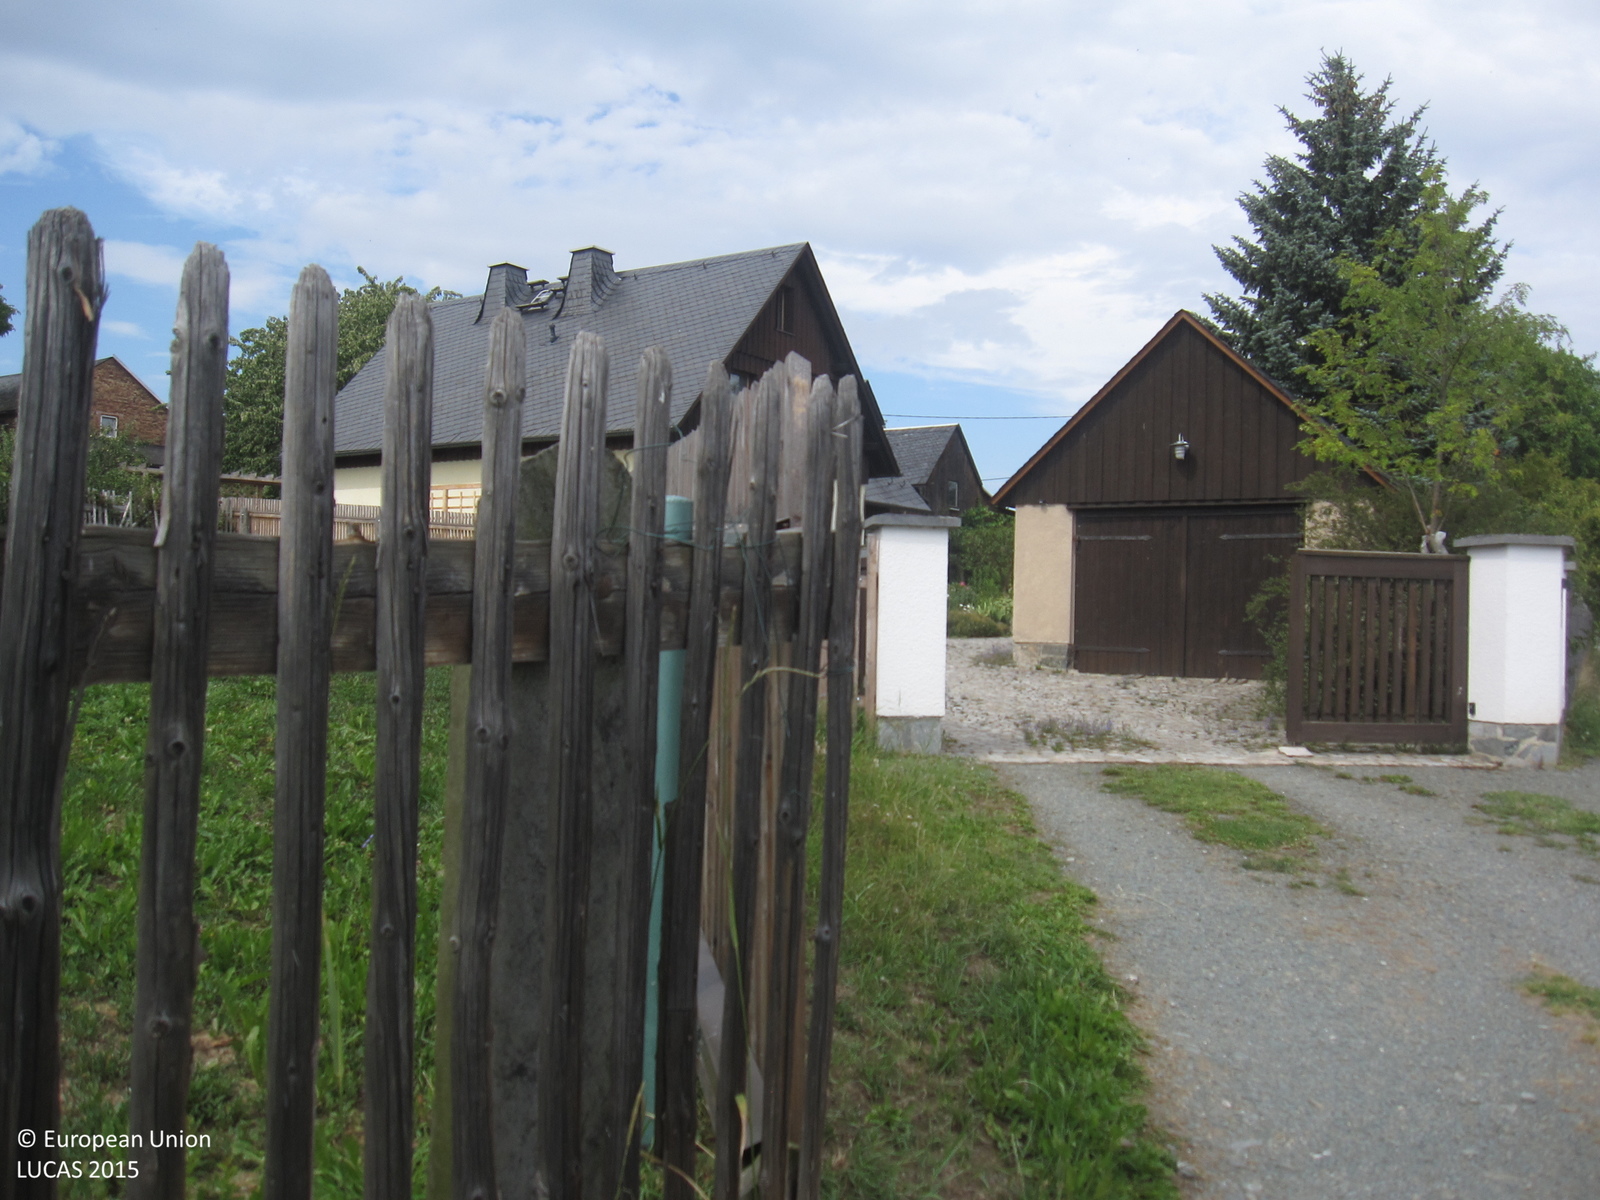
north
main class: Woodland
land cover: Broadleaved woodland
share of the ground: 25 - 50 %
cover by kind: herbaceous plants 65 %, broadleaved forest trees 35 %
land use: Residential
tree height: > 5 m
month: August
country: DE
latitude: 50.5601
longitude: 12.1312
